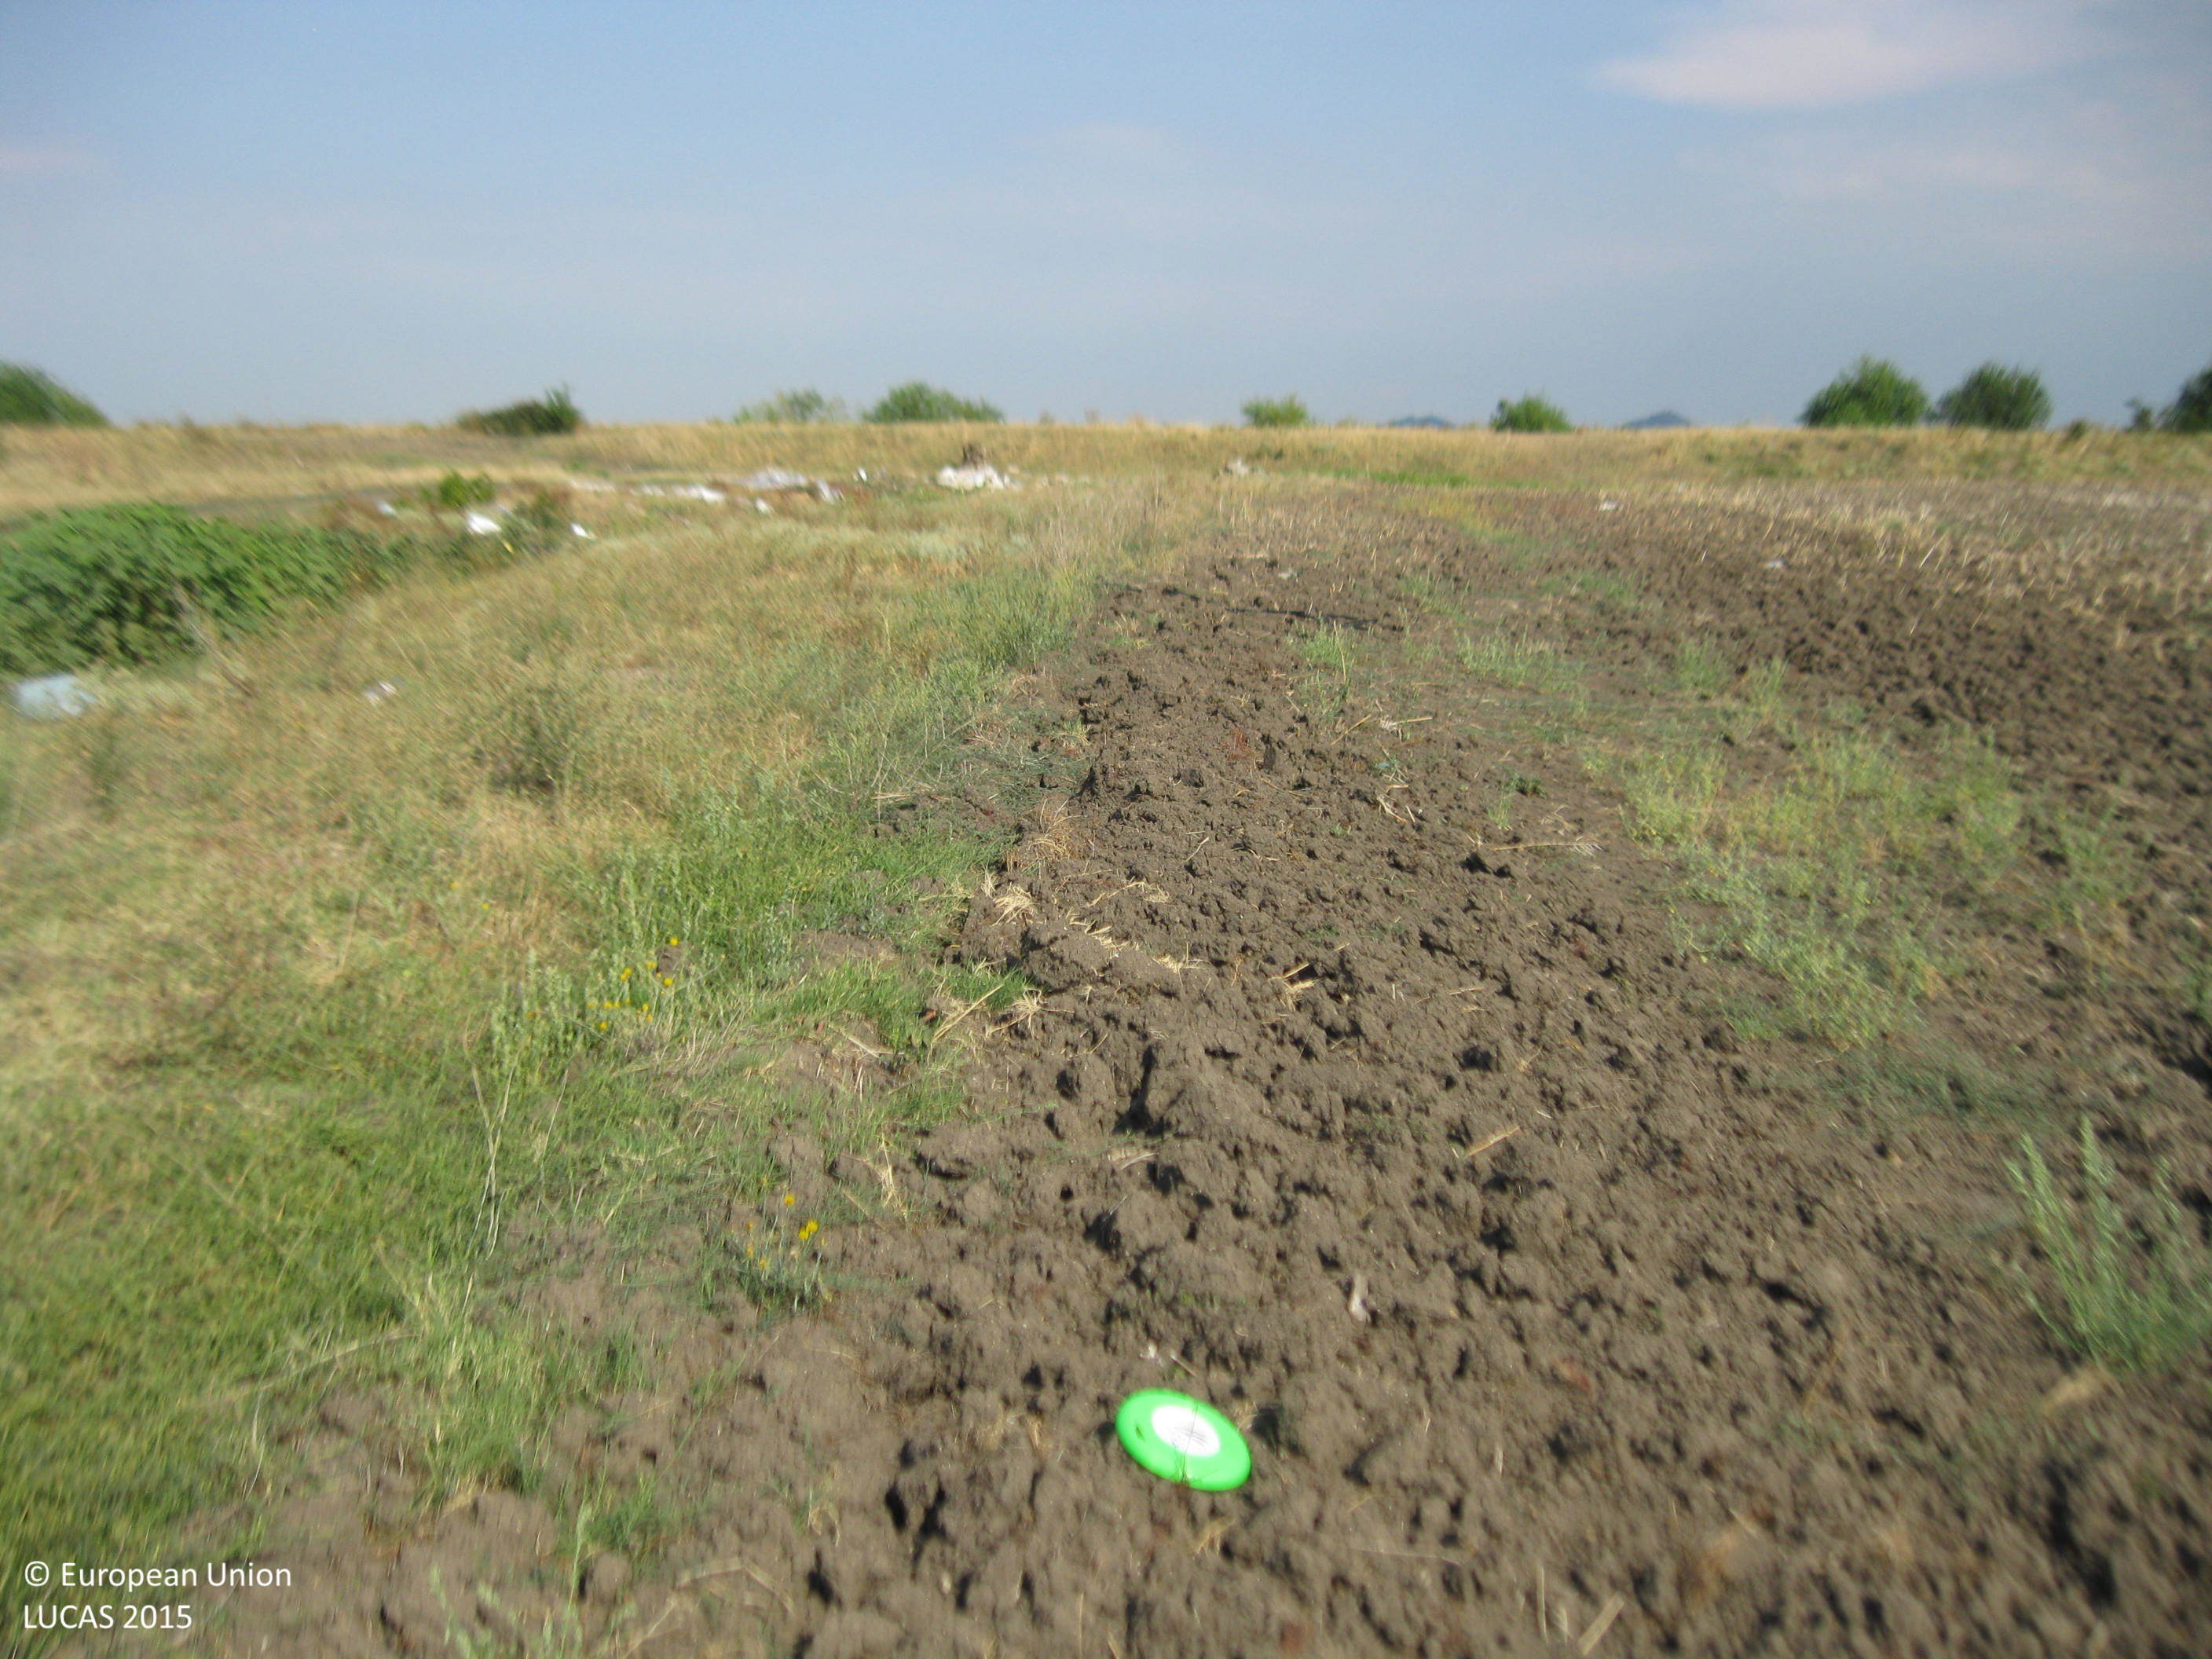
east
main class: Cropland
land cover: Rape and turnip rape
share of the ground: < 10 %
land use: Agriculture (excluding fallow land and kitchen gardens)
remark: Harvested field
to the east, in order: Rape and turnip rape; Grassland without tree/shrub cover; Shruby margins; Inland fresh running water; Grassland without tree/shrub cover; Tracks; Grassland without tree/shrub cover; Rice
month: August
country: BG
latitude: 42.1706
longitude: 24.6365
